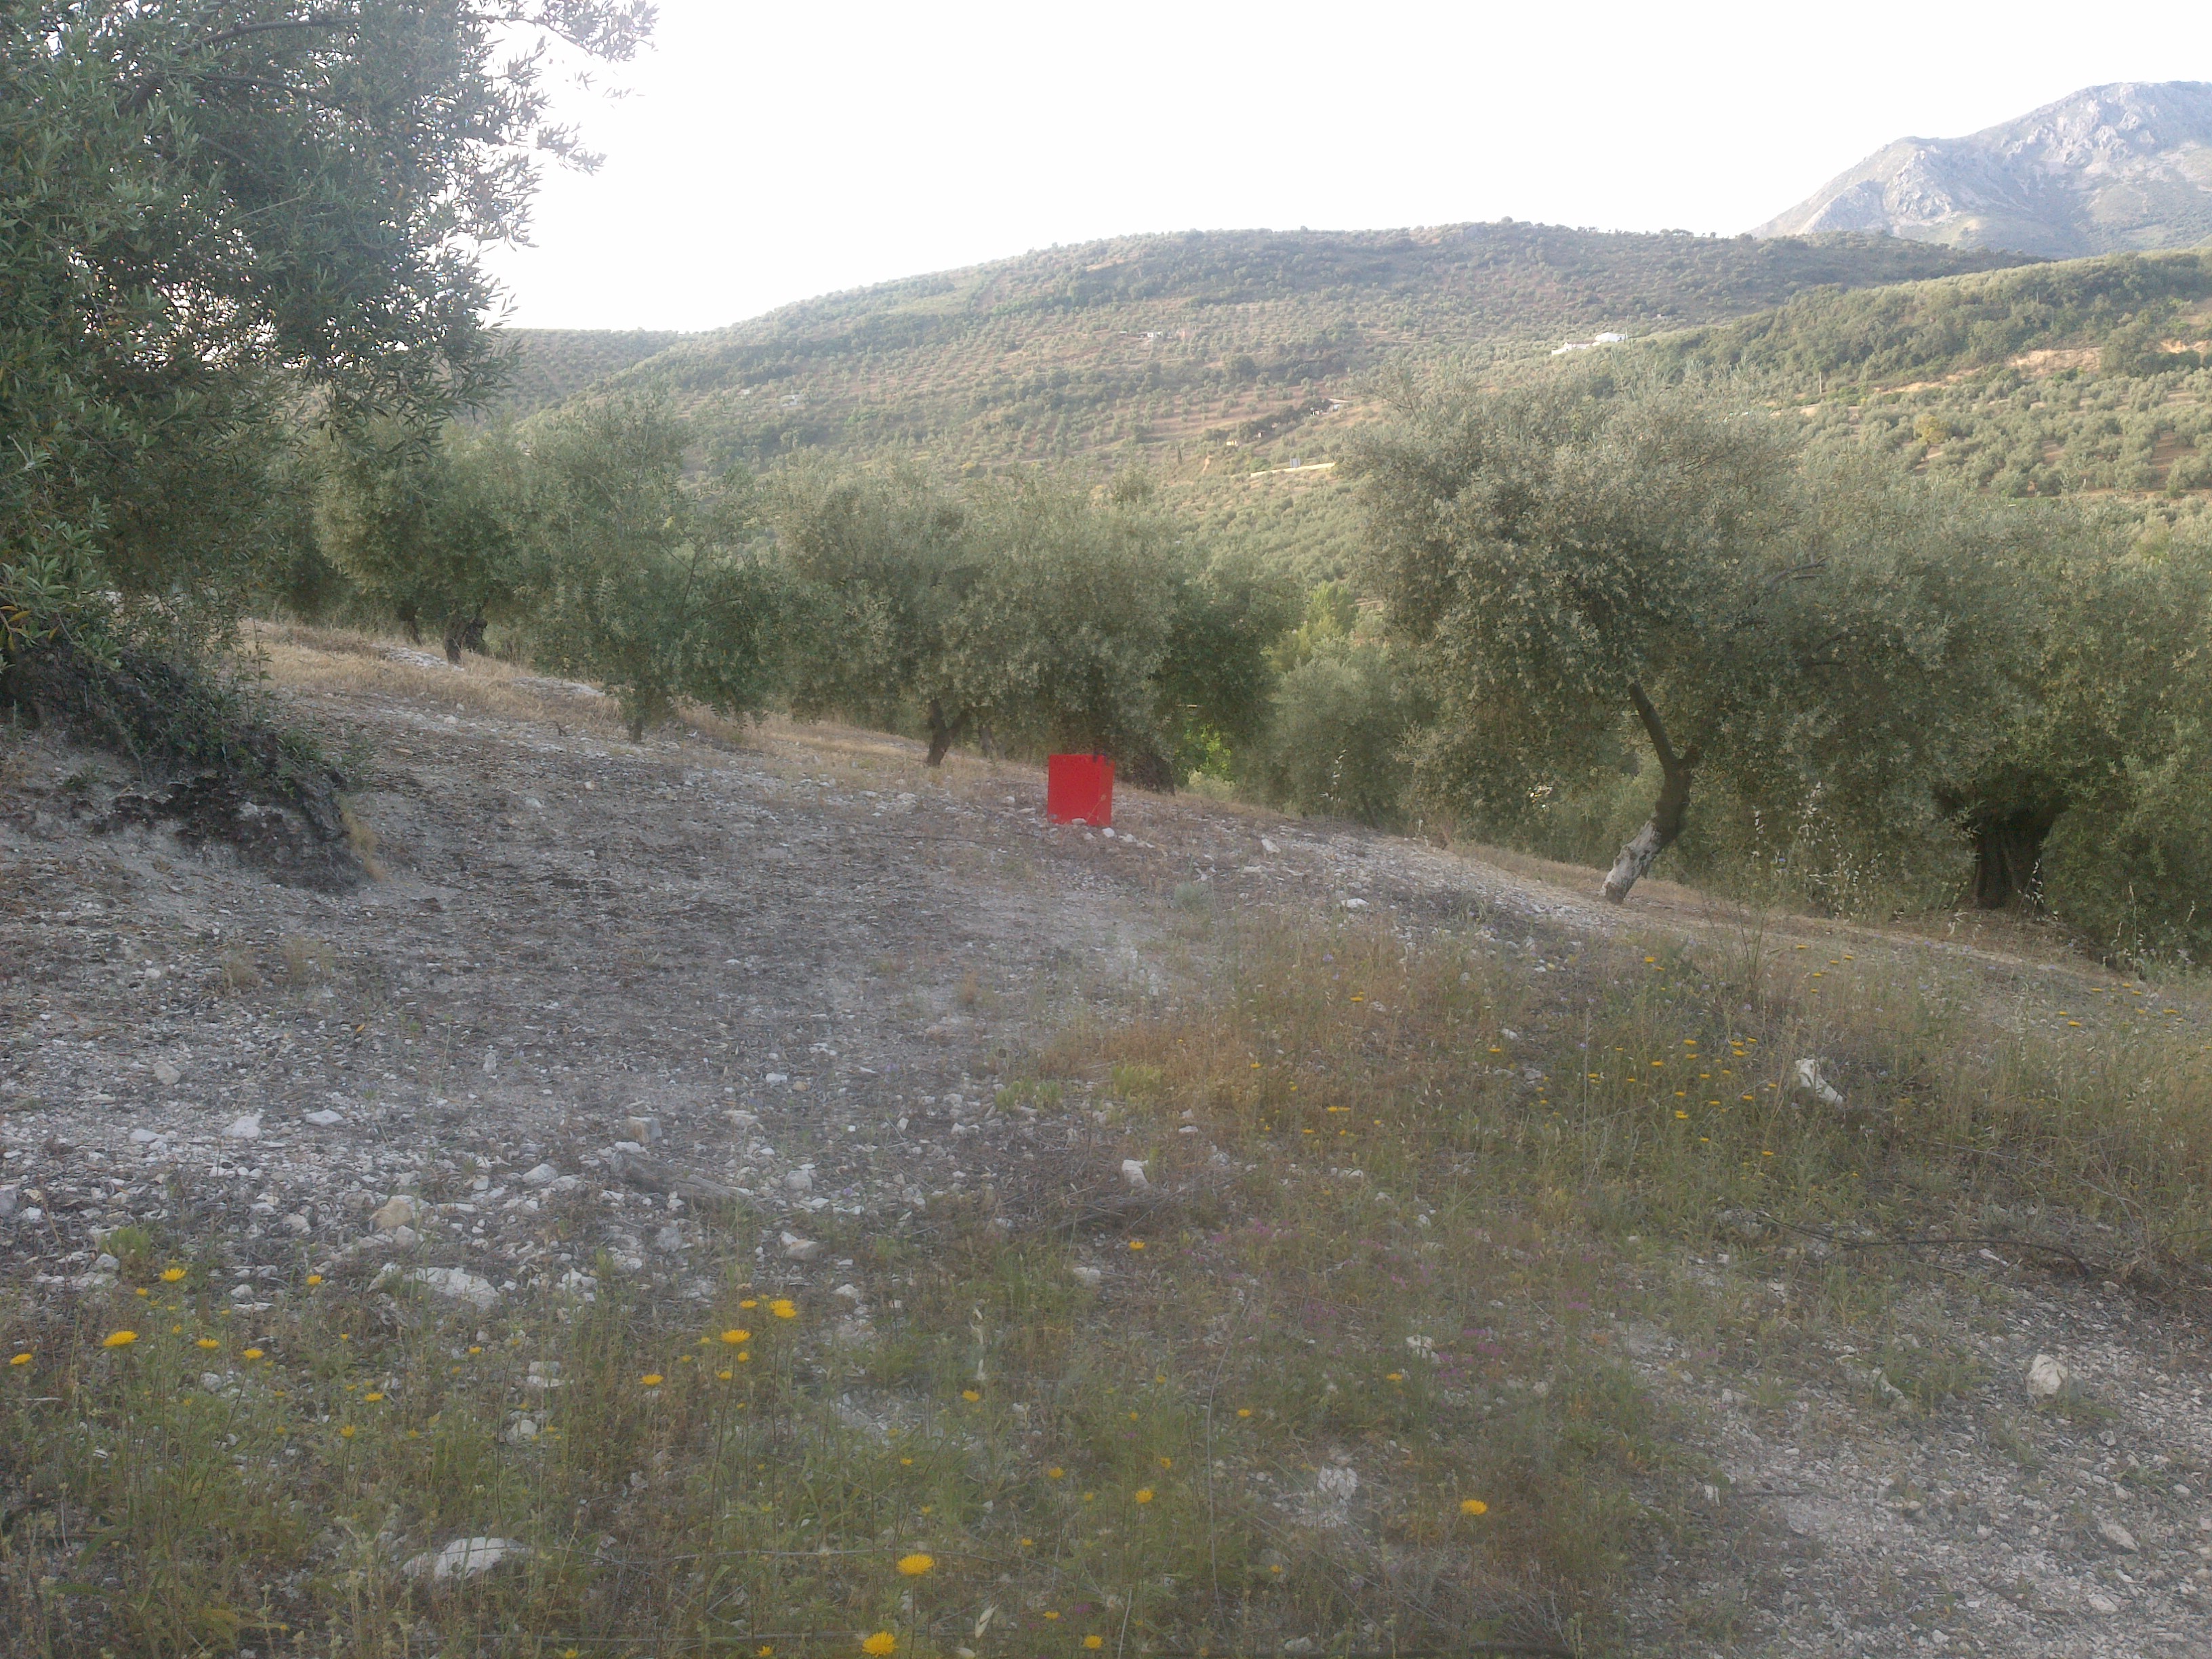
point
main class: Cropland
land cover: Olive groves
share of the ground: 50 - 75 %
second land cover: Spontaneously vegetated surfaces
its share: 10 - 25 %
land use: Agriculture (excluding fallow land and kitchen gardens)
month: May
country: ES
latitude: 37.4433
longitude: -4.2306
